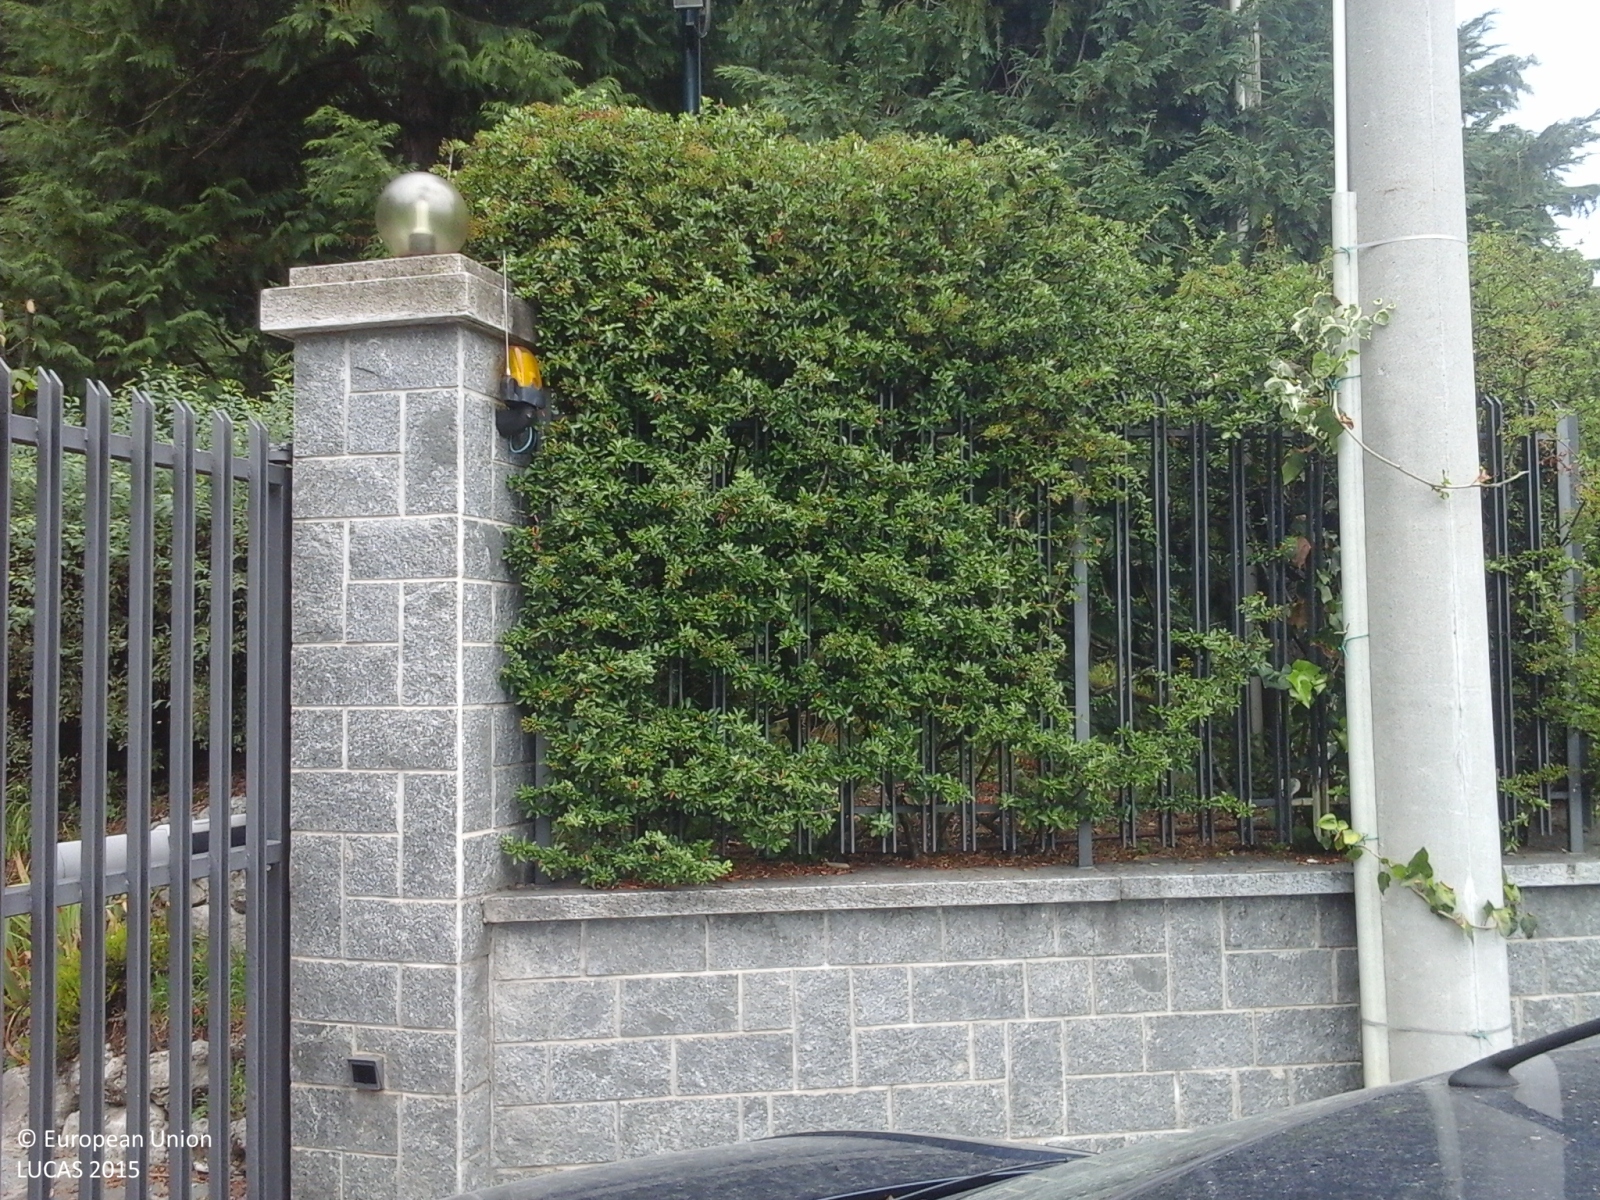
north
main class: Woodland
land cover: Broadleaved woodland
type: thermophilous deciduous forest
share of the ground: > 75 %
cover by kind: broadleaved forest trees 100 %
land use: Forestry
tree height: > 5 m
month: July
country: IT
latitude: 45.8441
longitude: 9.2415
